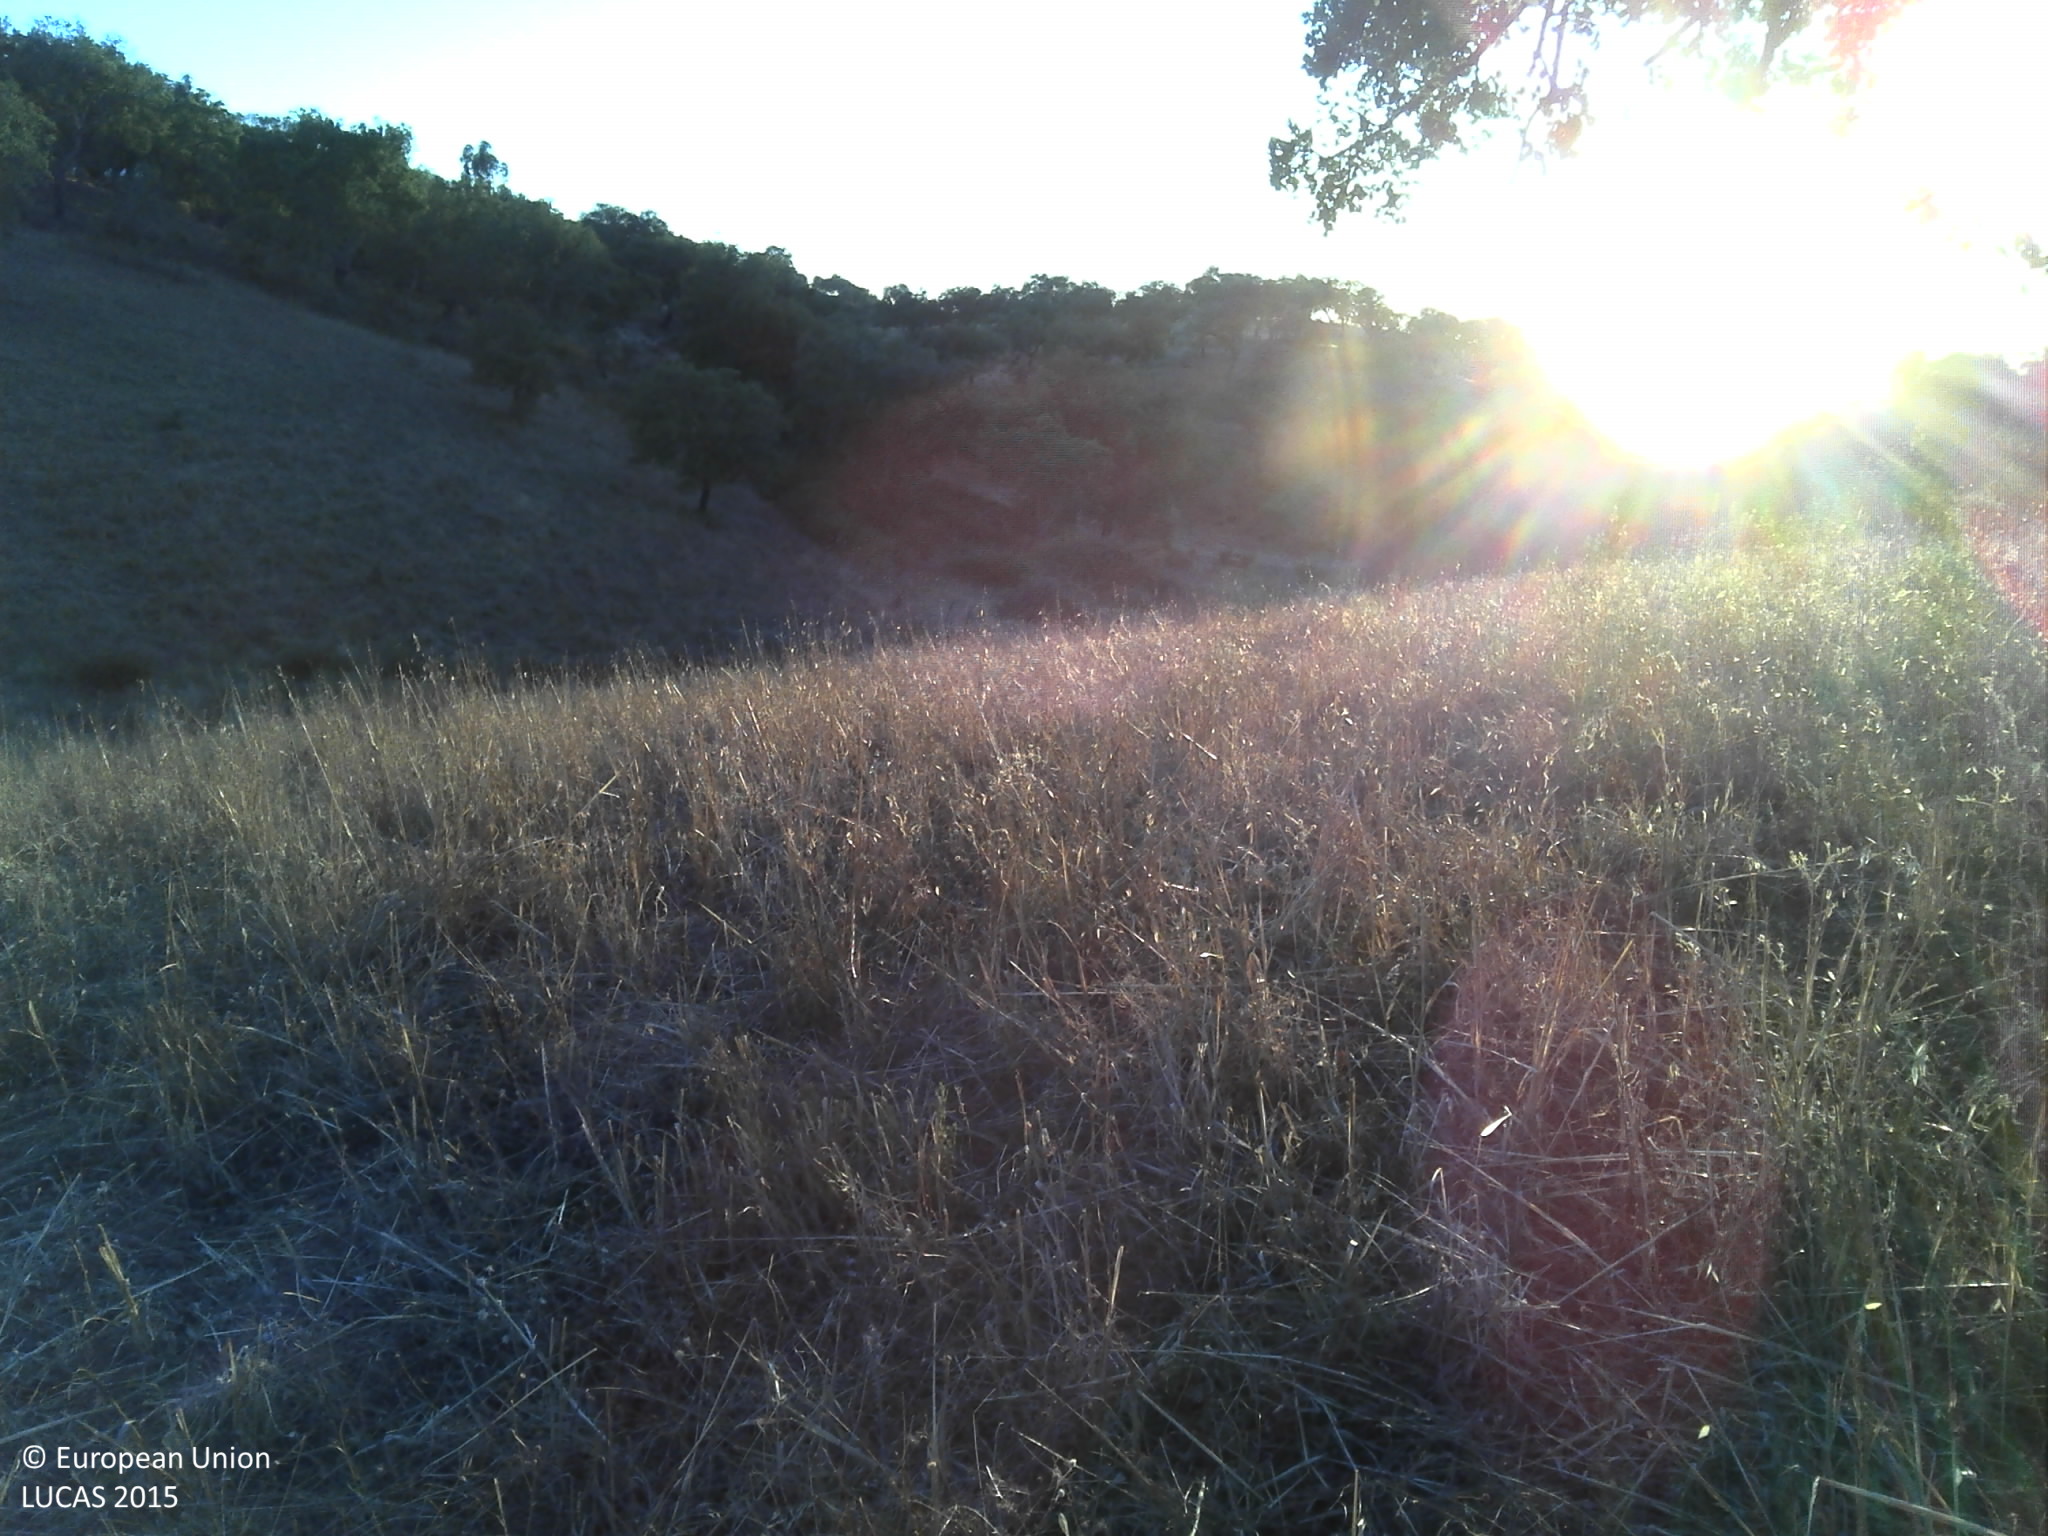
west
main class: Woodland
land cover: Broadleaved woodland
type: broadleaved evergreen forest
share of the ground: 10 - 25 %
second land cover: Spontaneously vegetated surfaces
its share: 50 - 75 %
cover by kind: herbaceous plants 50 %, broadleaved forest trees 25 %, unconsolidated bare surface 25 %
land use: Forestry
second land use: Agriculture (excluding fallow land and kitchen gardens)
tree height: > 5 m
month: June
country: PT
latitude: 37.8851
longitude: -7.3068
